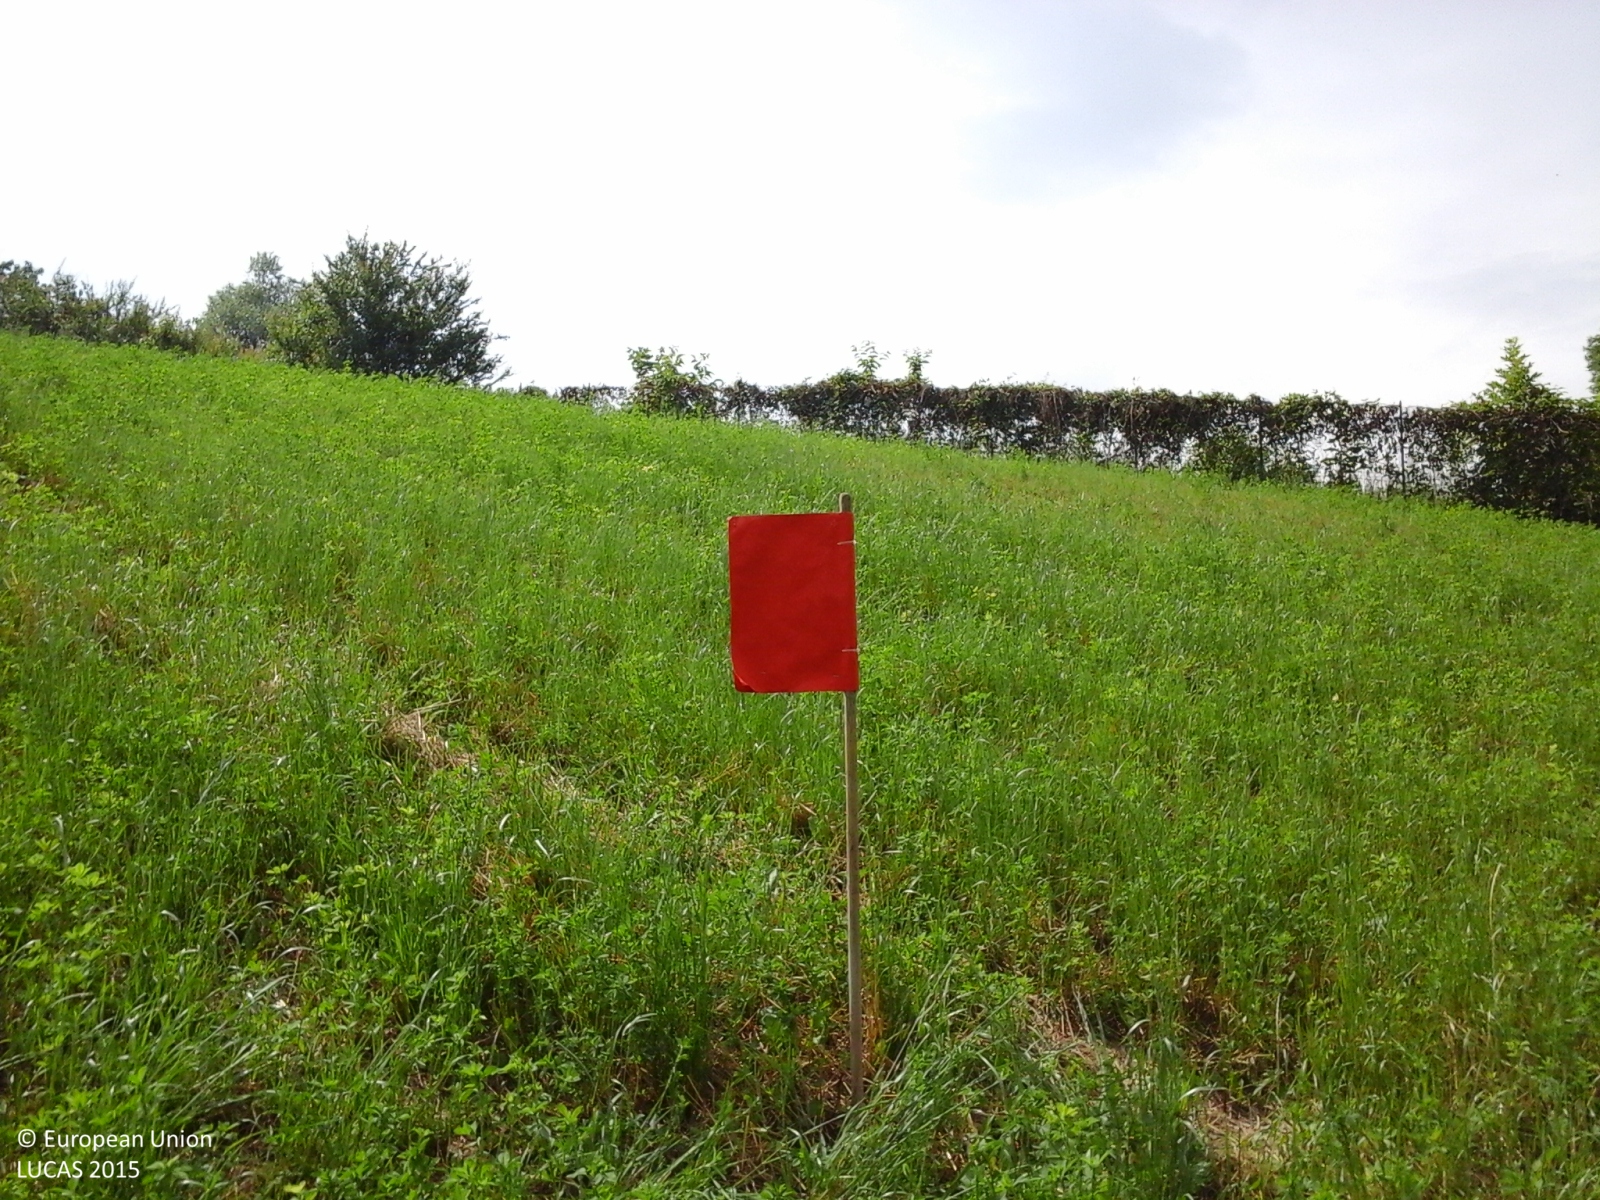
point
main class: Cropland
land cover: Lucerne
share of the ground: > 75 %
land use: Agriculture (excluding fallow land and kitchen gardens)
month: June
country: IT
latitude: 44.8006
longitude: 9.6089
